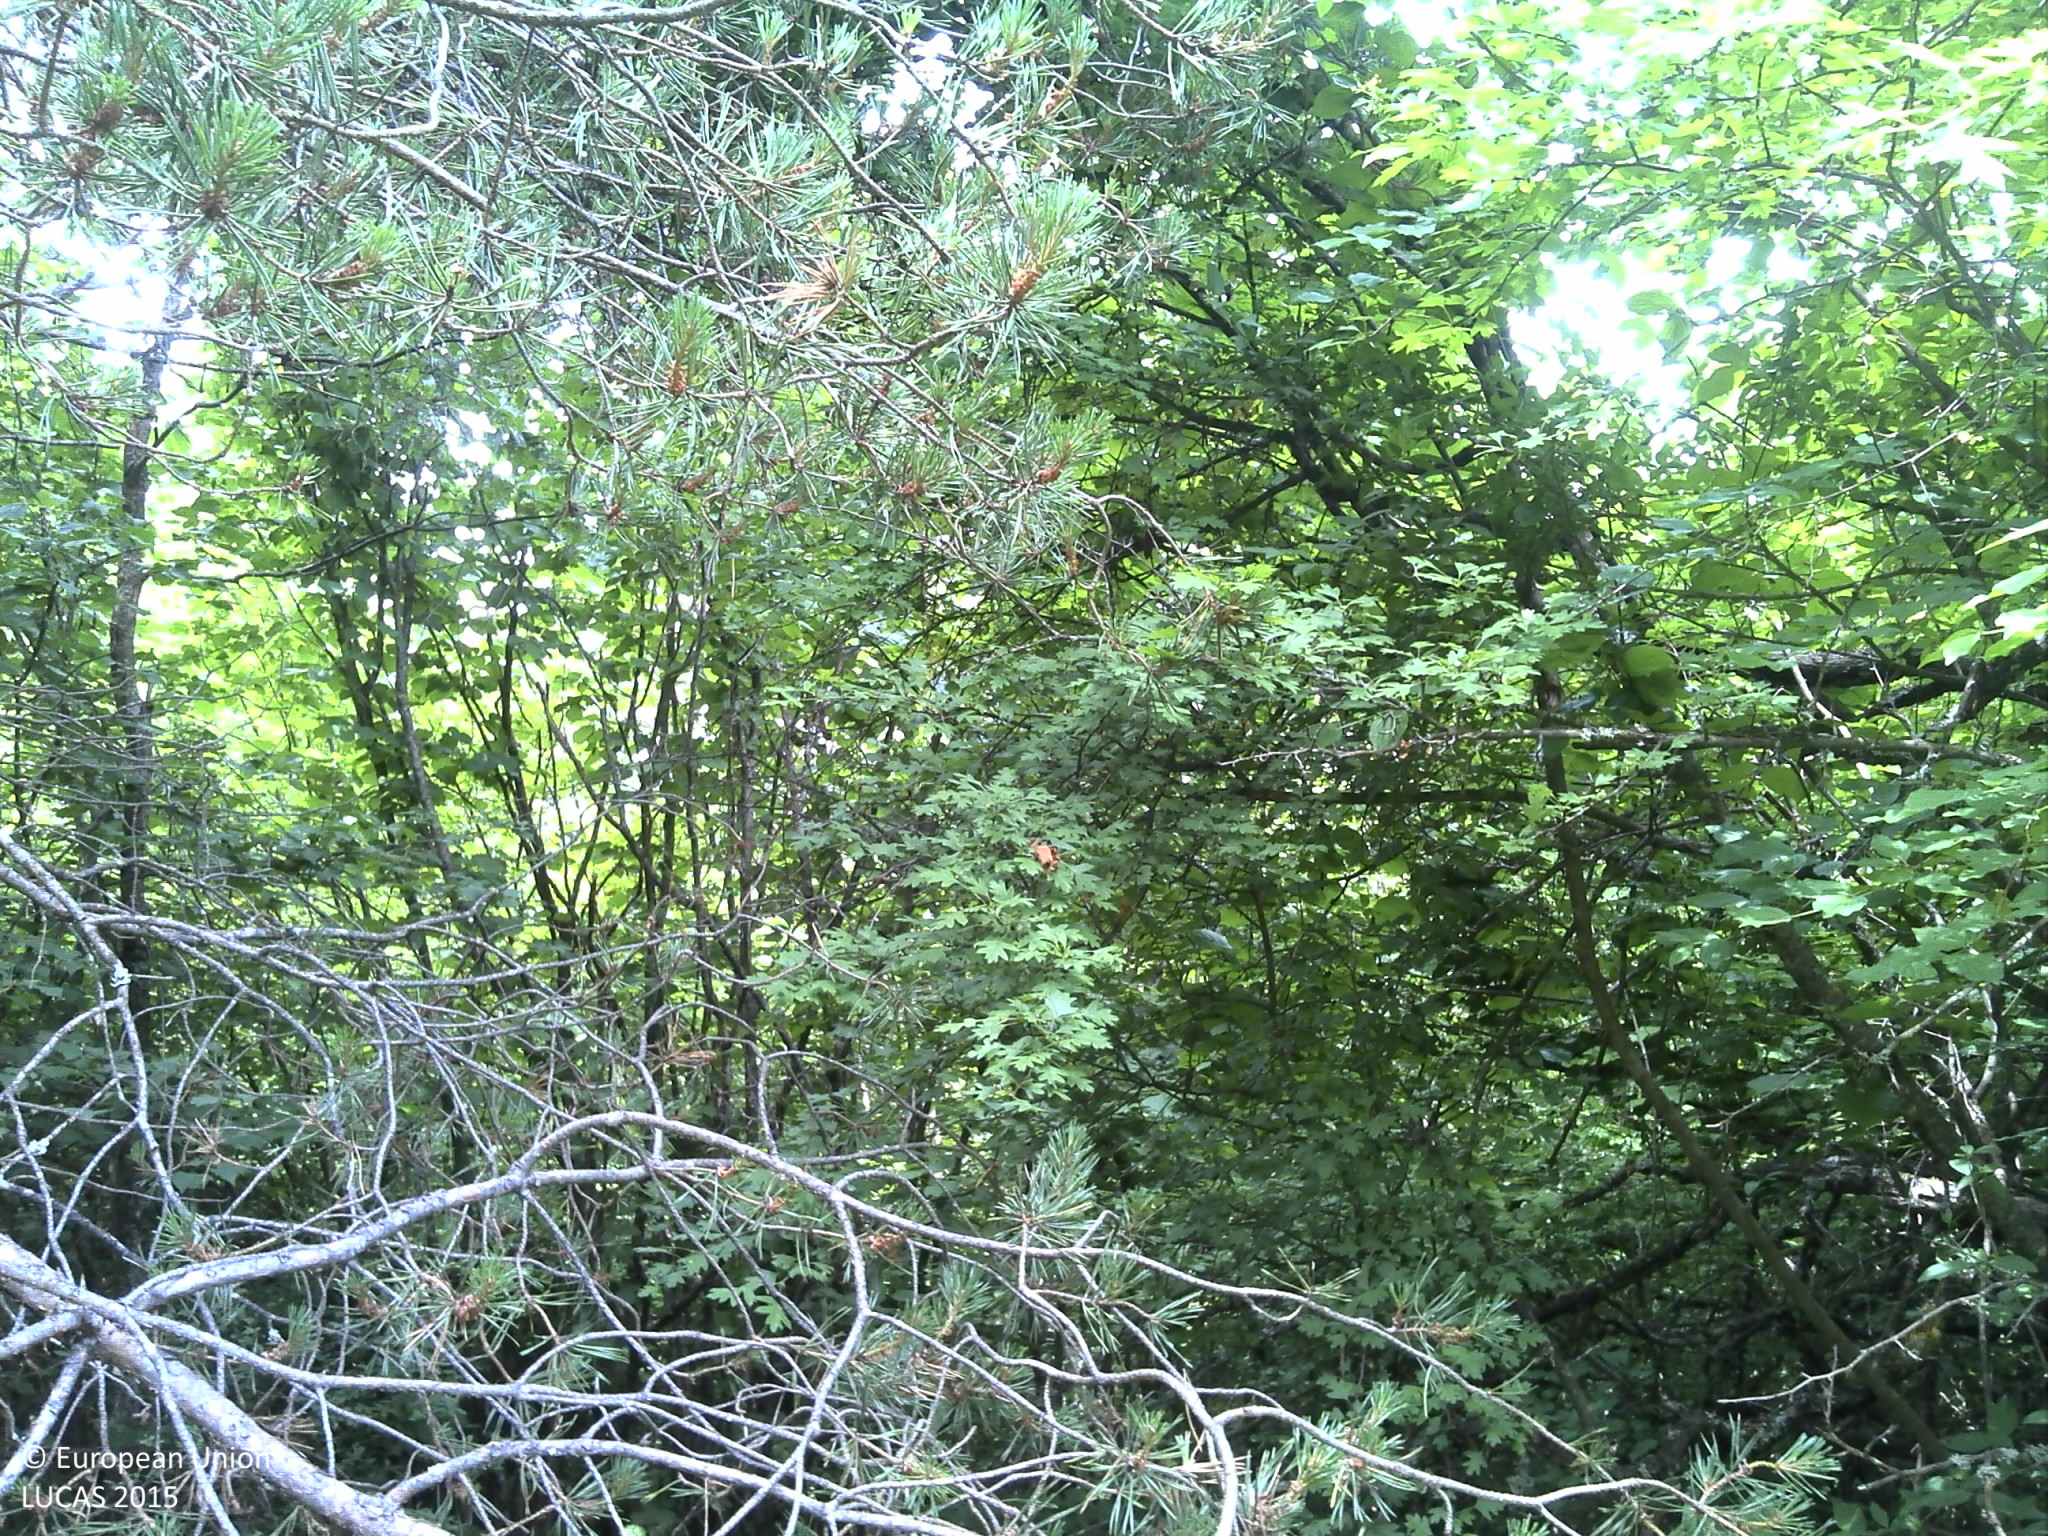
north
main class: Woodland
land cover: Pine dominated coniferous woodland
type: hemiboreal forest and nemoral coniferous forest and mixed broadleaved-coniferous forest
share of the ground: 50 - 75 %
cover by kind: coniferous forest trees 50 %, herbaceous plants 40 %, broadleaved forest trees 10 %
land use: Semi-natural and natural areas not in use
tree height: > 5 m
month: June
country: HR
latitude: 44.4804
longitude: 16.0665
